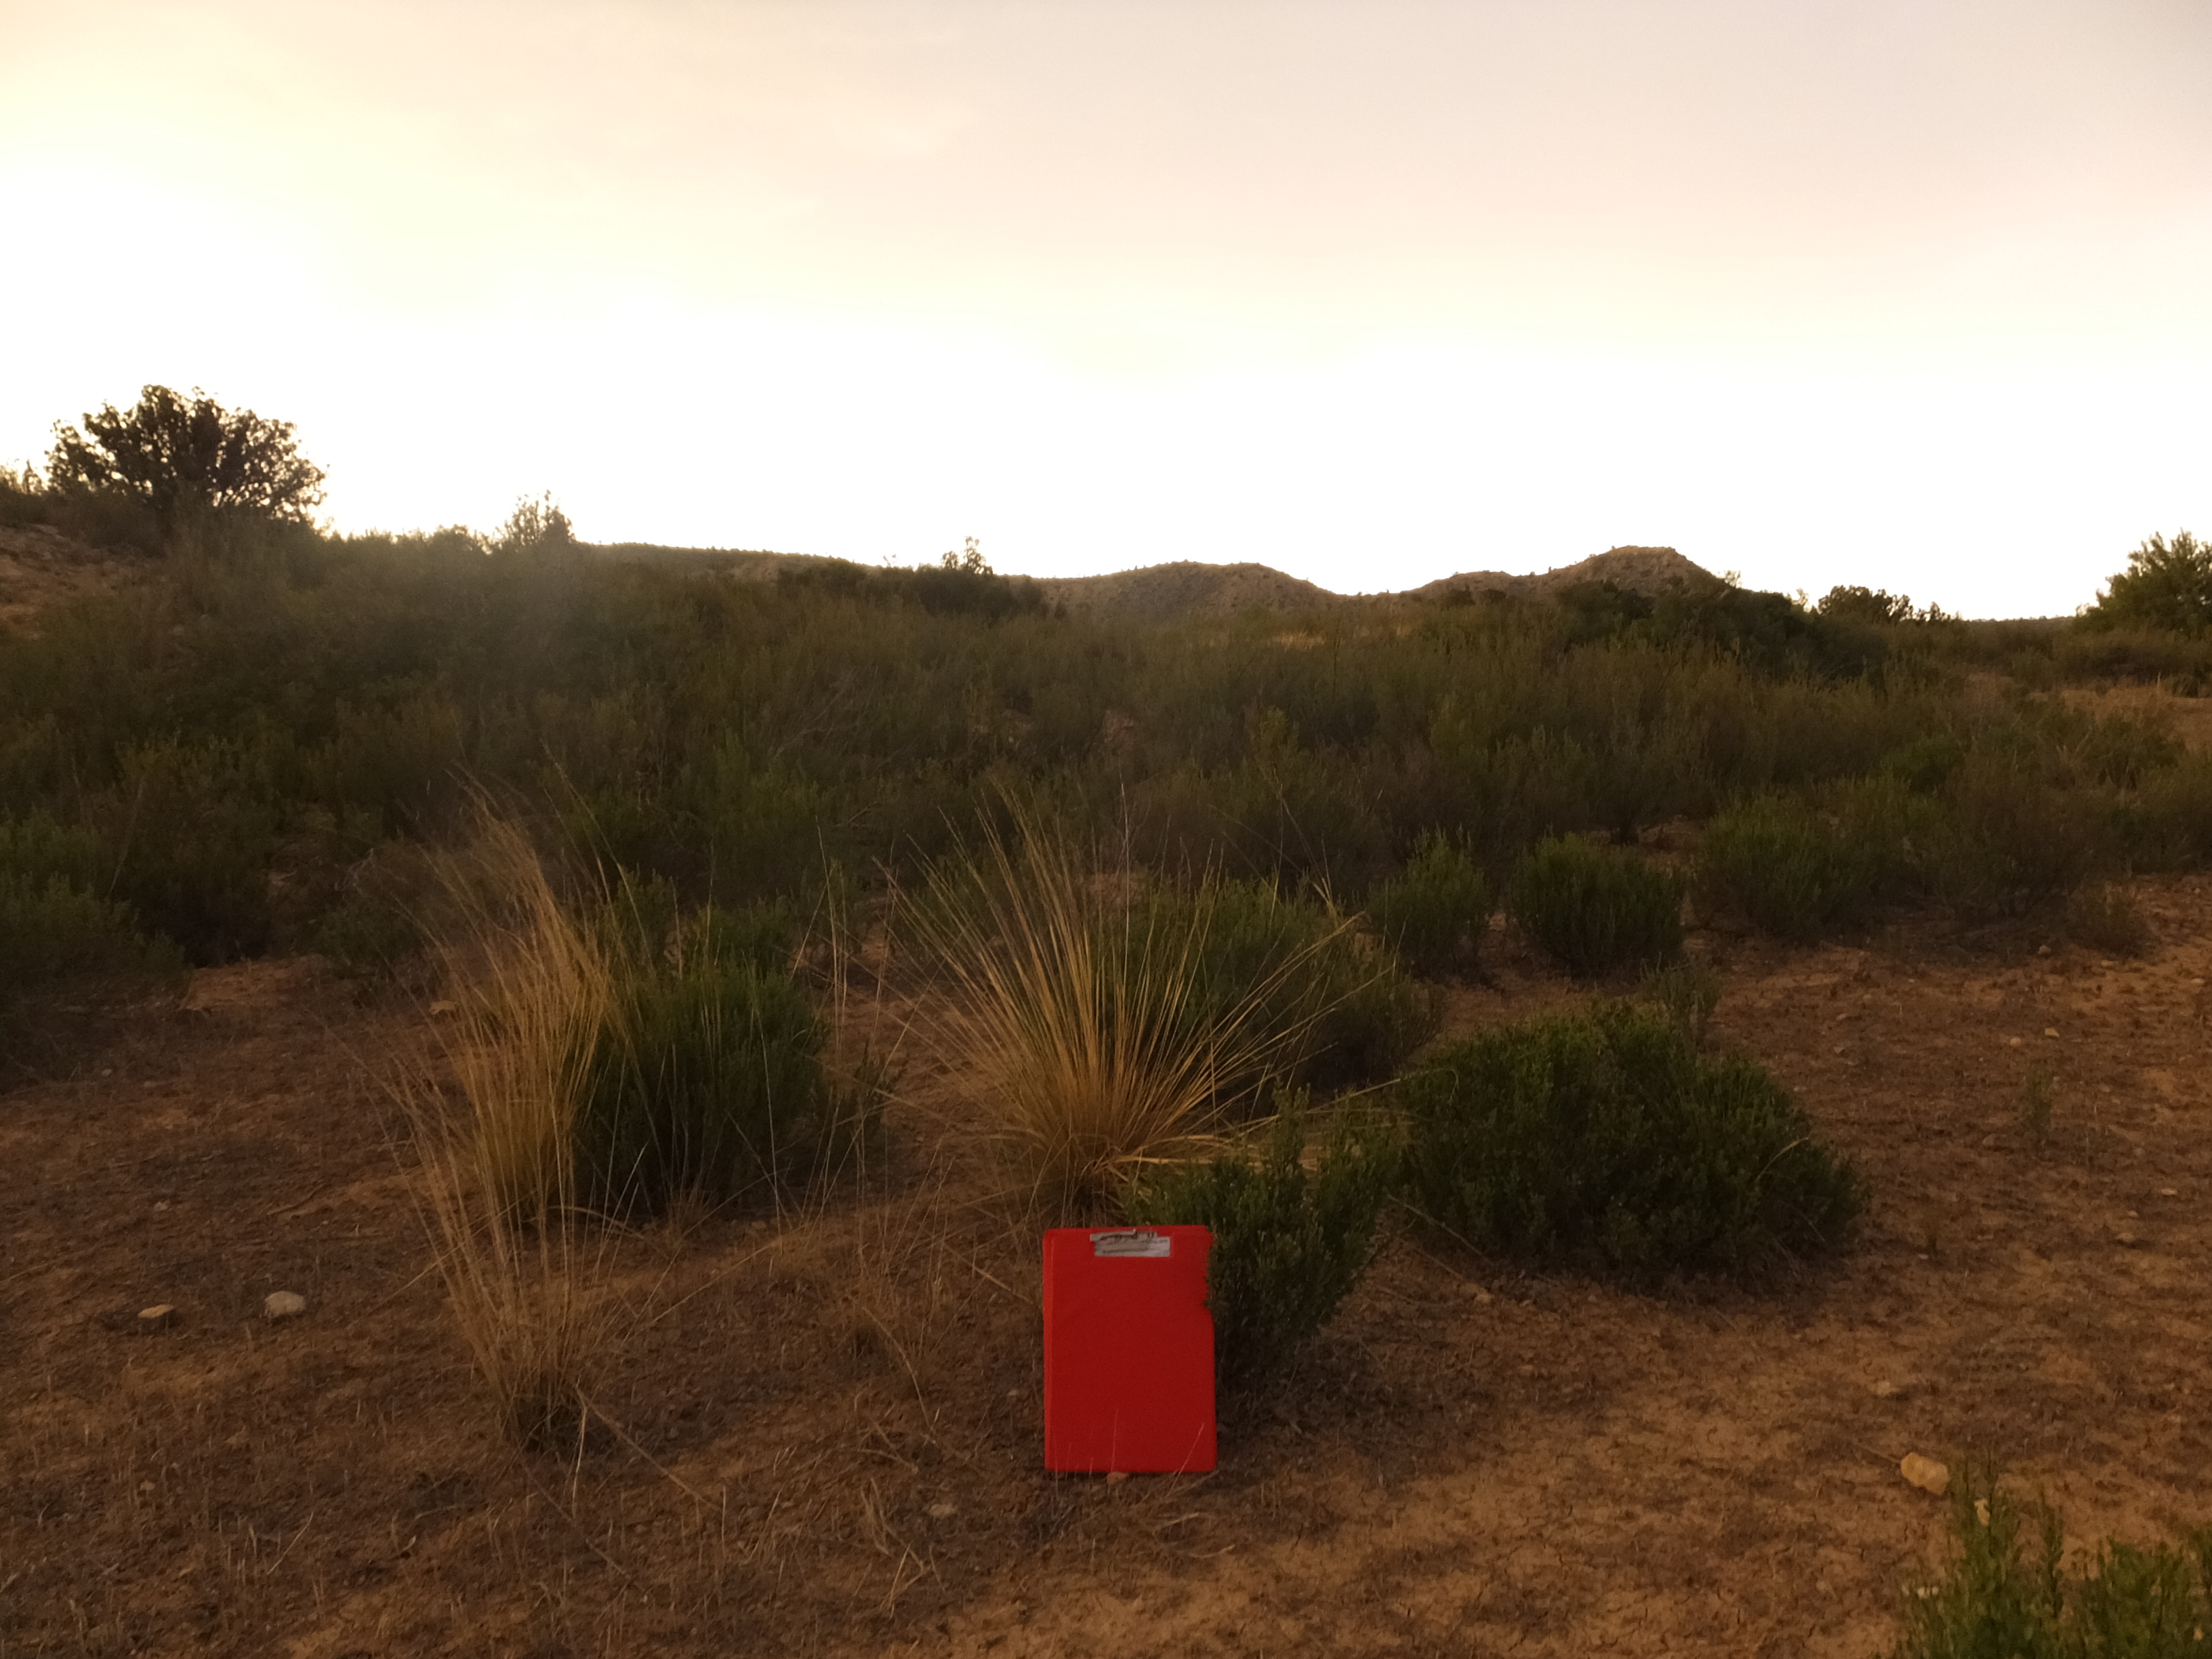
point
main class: Shrubland
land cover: Shrubland with sparse tree cover
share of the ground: > 75 %
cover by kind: shrubs 70 %, herbaceous plants 20 %, coniferous forest trees 5 %, consolidated bare surface 5 %
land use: Semi-natural and natural areas not in use
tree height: < 5 m
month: August
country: ES
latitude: 41.3473
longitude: 0.0794
